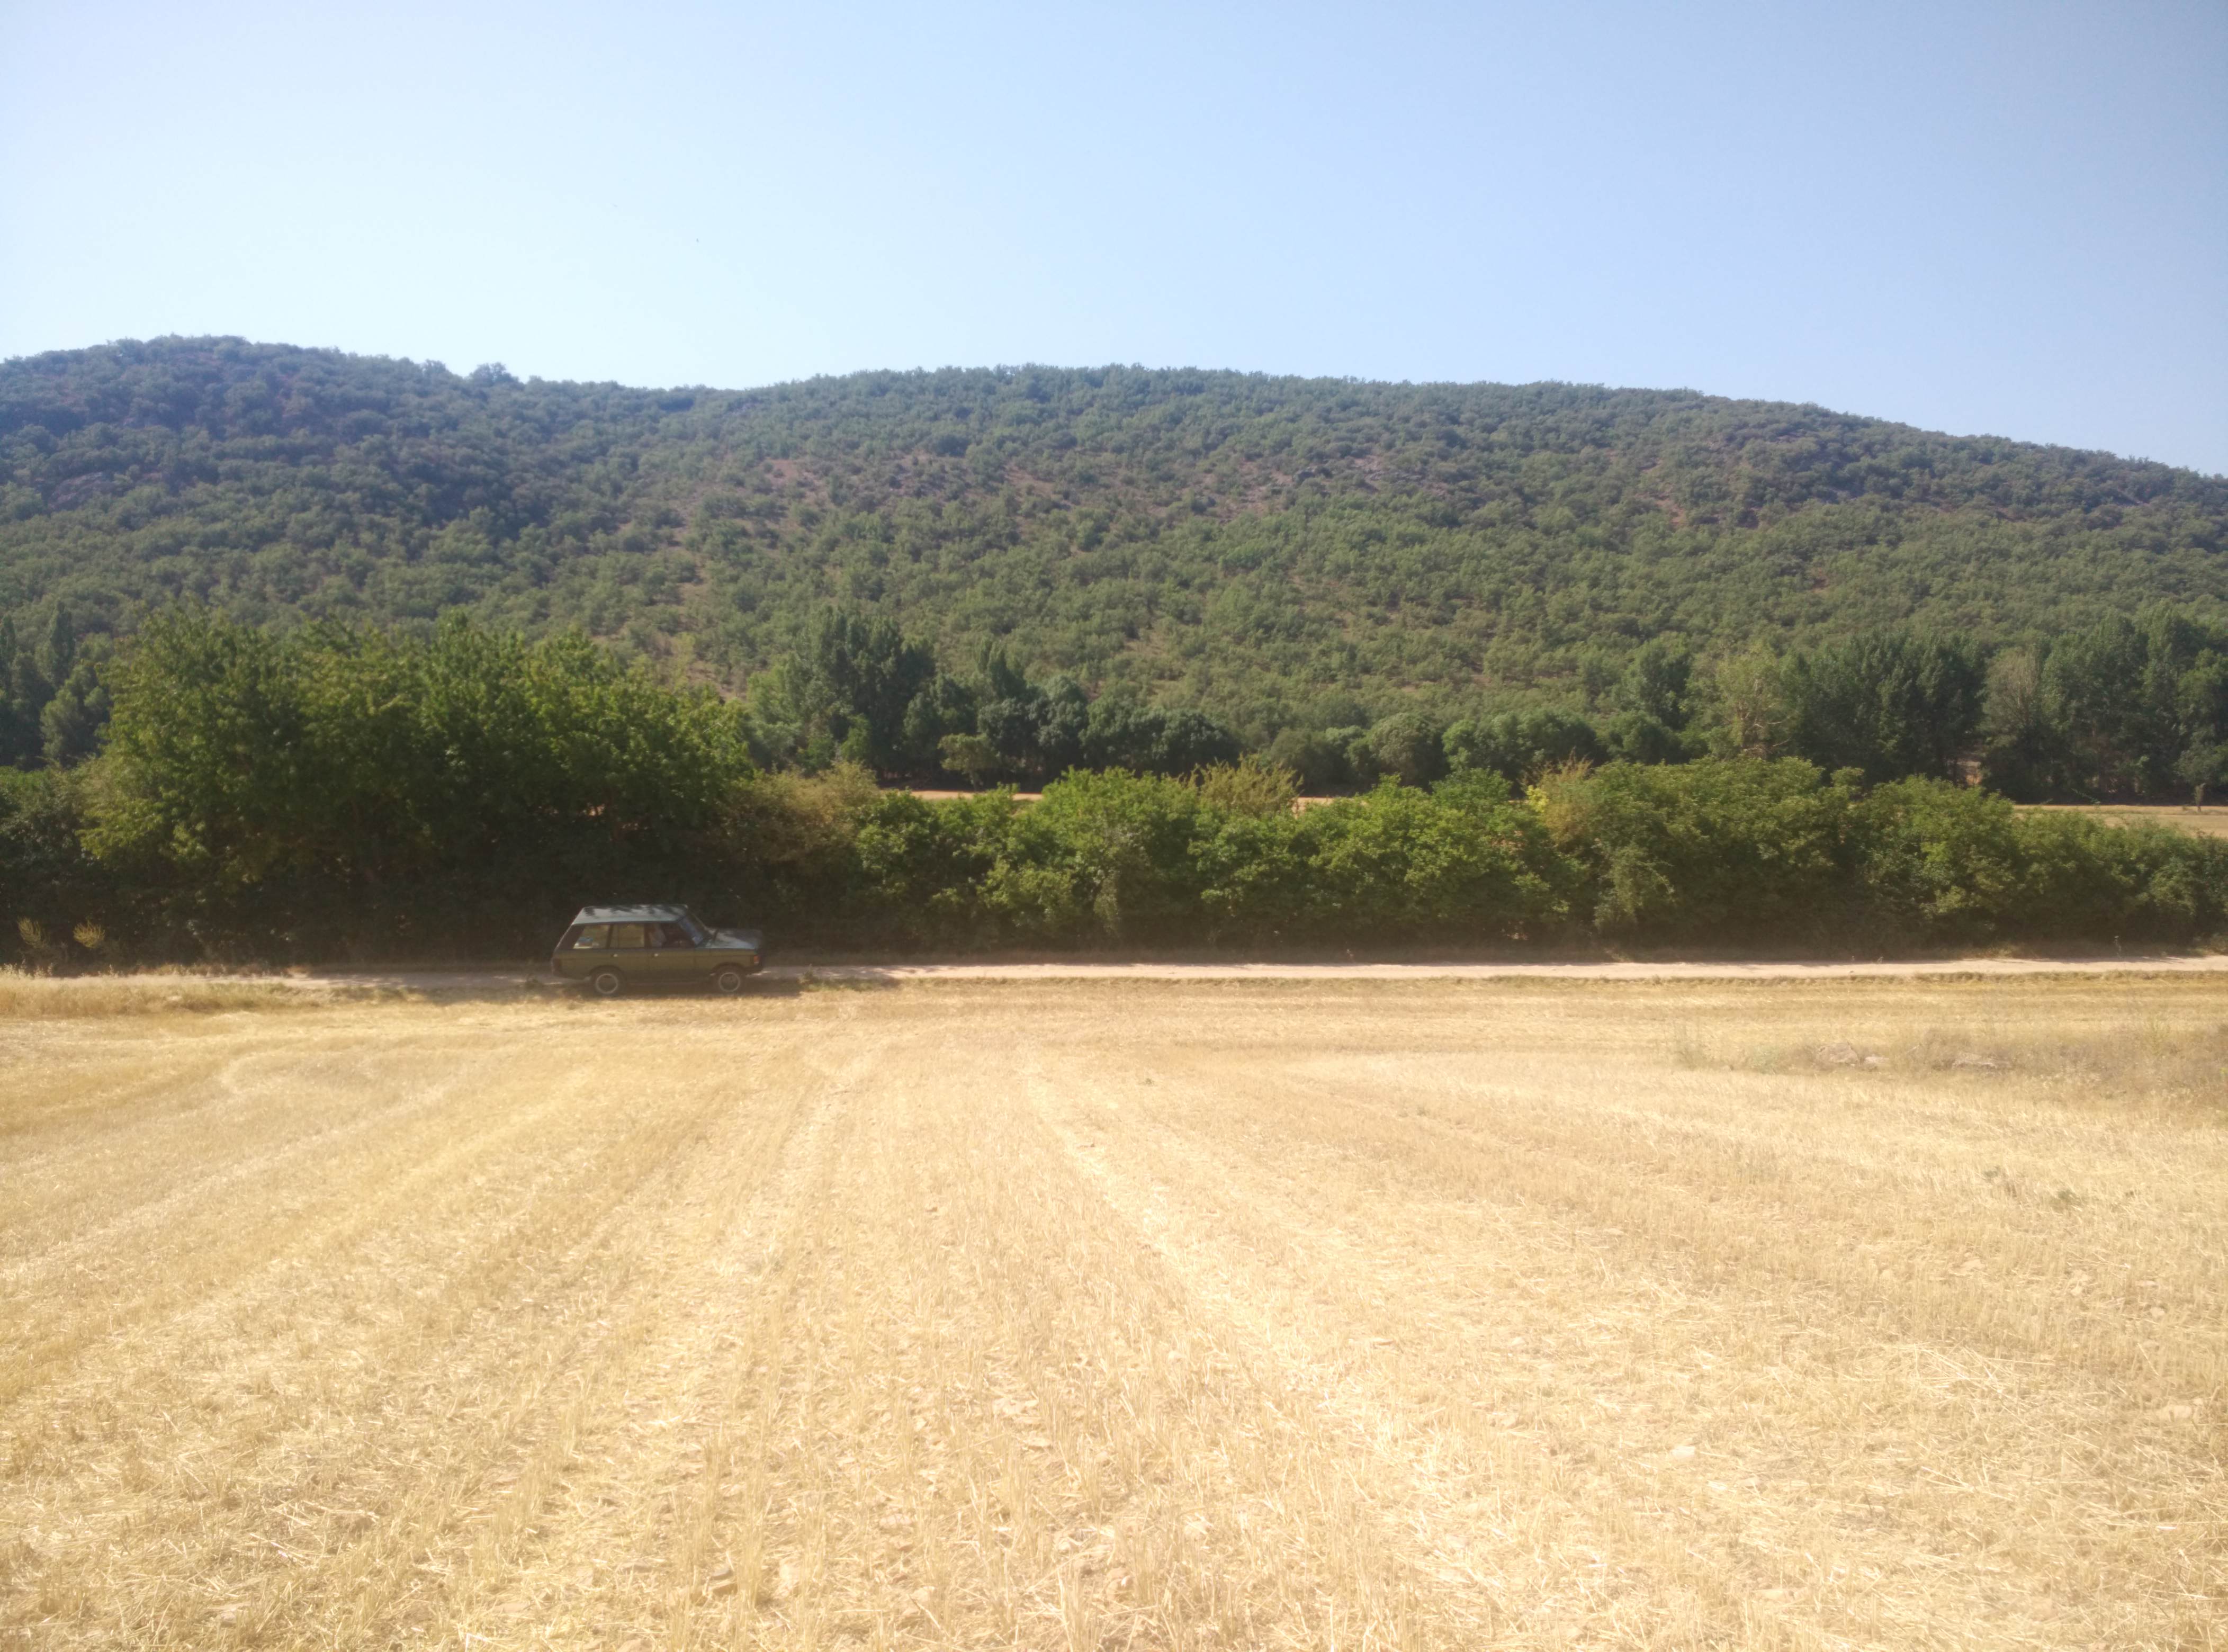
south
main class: Cropland
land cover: Common wheat
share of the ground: < 10 %
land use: Agriculture (excluding fallow land and kitchen gardens)
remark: Harvested field
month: July
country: ES
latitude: 41.0174
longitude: -2.6489
